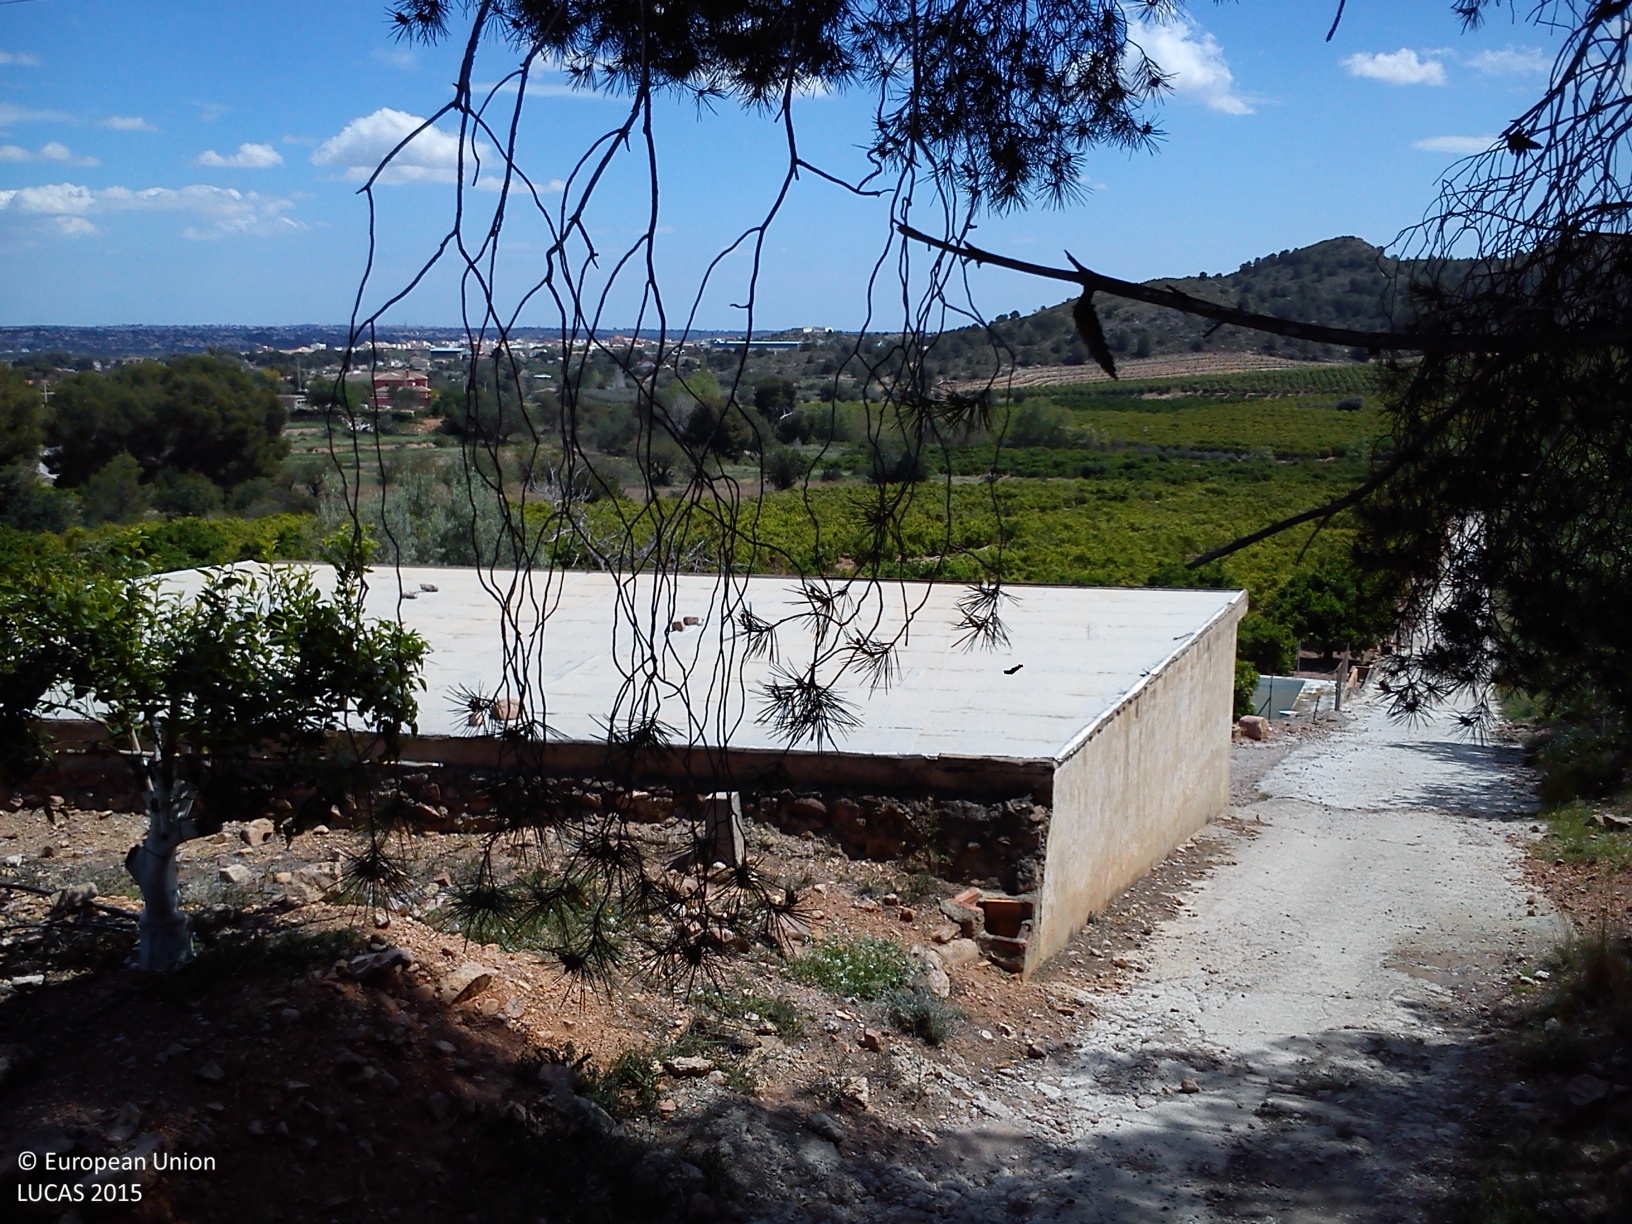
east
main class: Woodland
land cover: Pine dominated coniferous woodland
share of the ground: > 75 %
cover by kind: coniferous forest trees 85 %, shrubs 10 %, herbaceous plants 5 %
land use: Forestry
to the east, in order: Pine dominated coniferous woodland; Tracks; Oranges; Artificial constructions in urban areas; Oranges; Tracks; Permanent industrial crops; Dry stone walls; Tracks; Grass margins
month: April
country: ES
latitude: 39.5455
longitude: -0.6000
